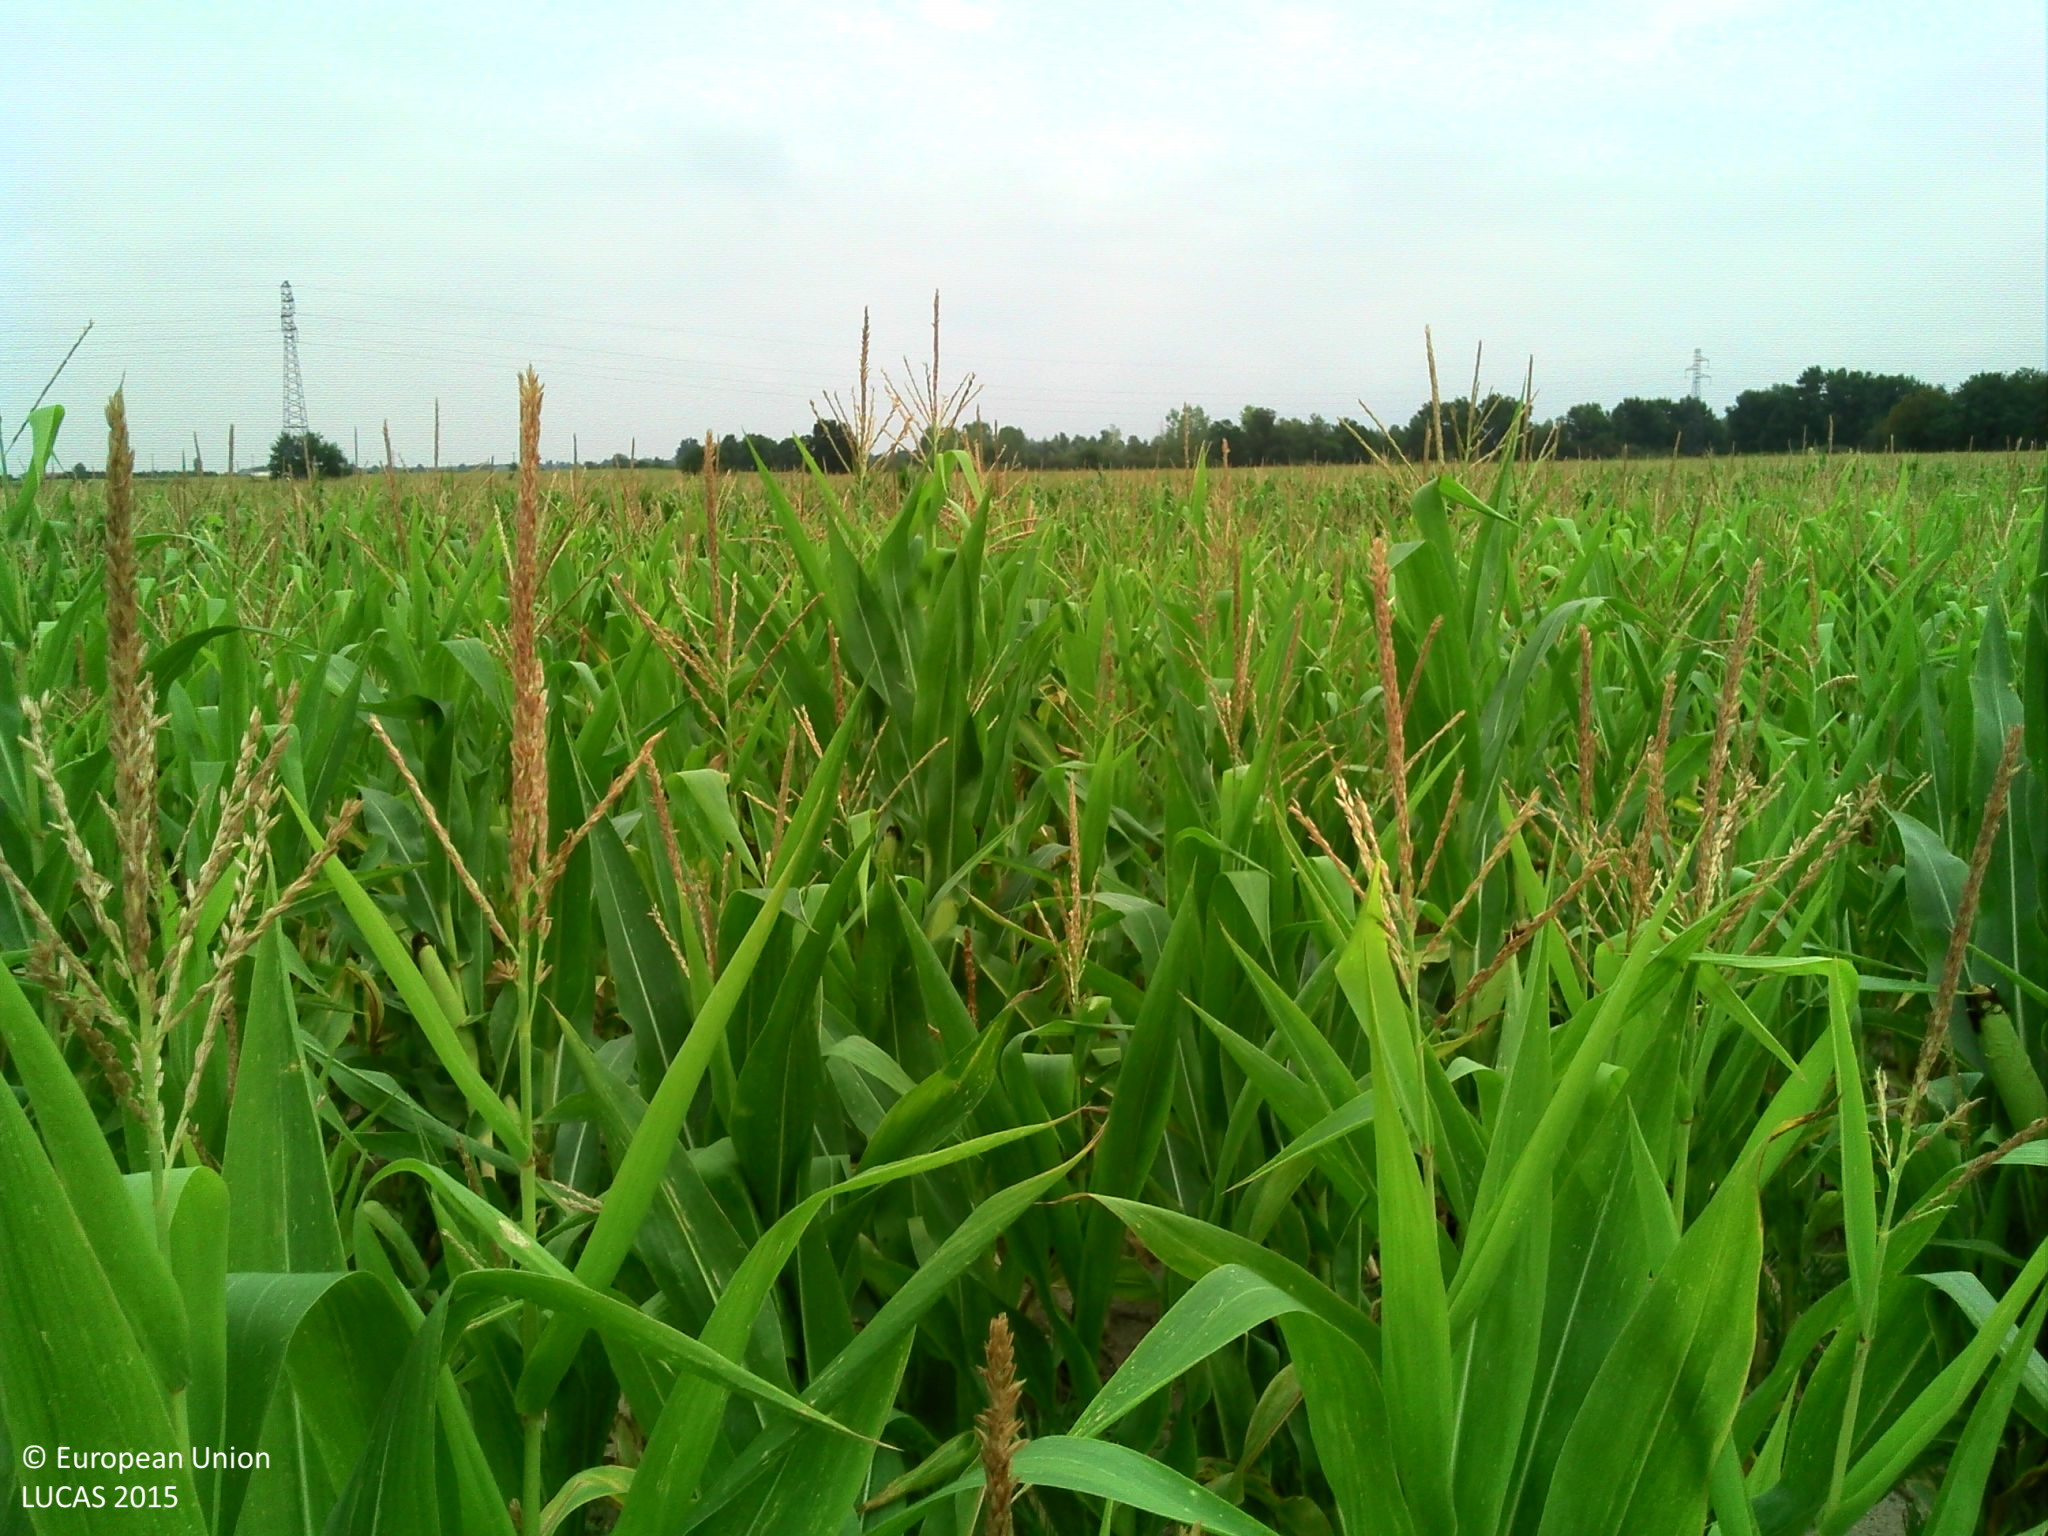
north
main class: Cropland
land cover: Maize
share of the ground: 50 - 75 %
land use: Agriculture (excluding fallow land and kitchen gardens)
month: August
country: FR
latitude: 45.6307
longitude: 4.1408
